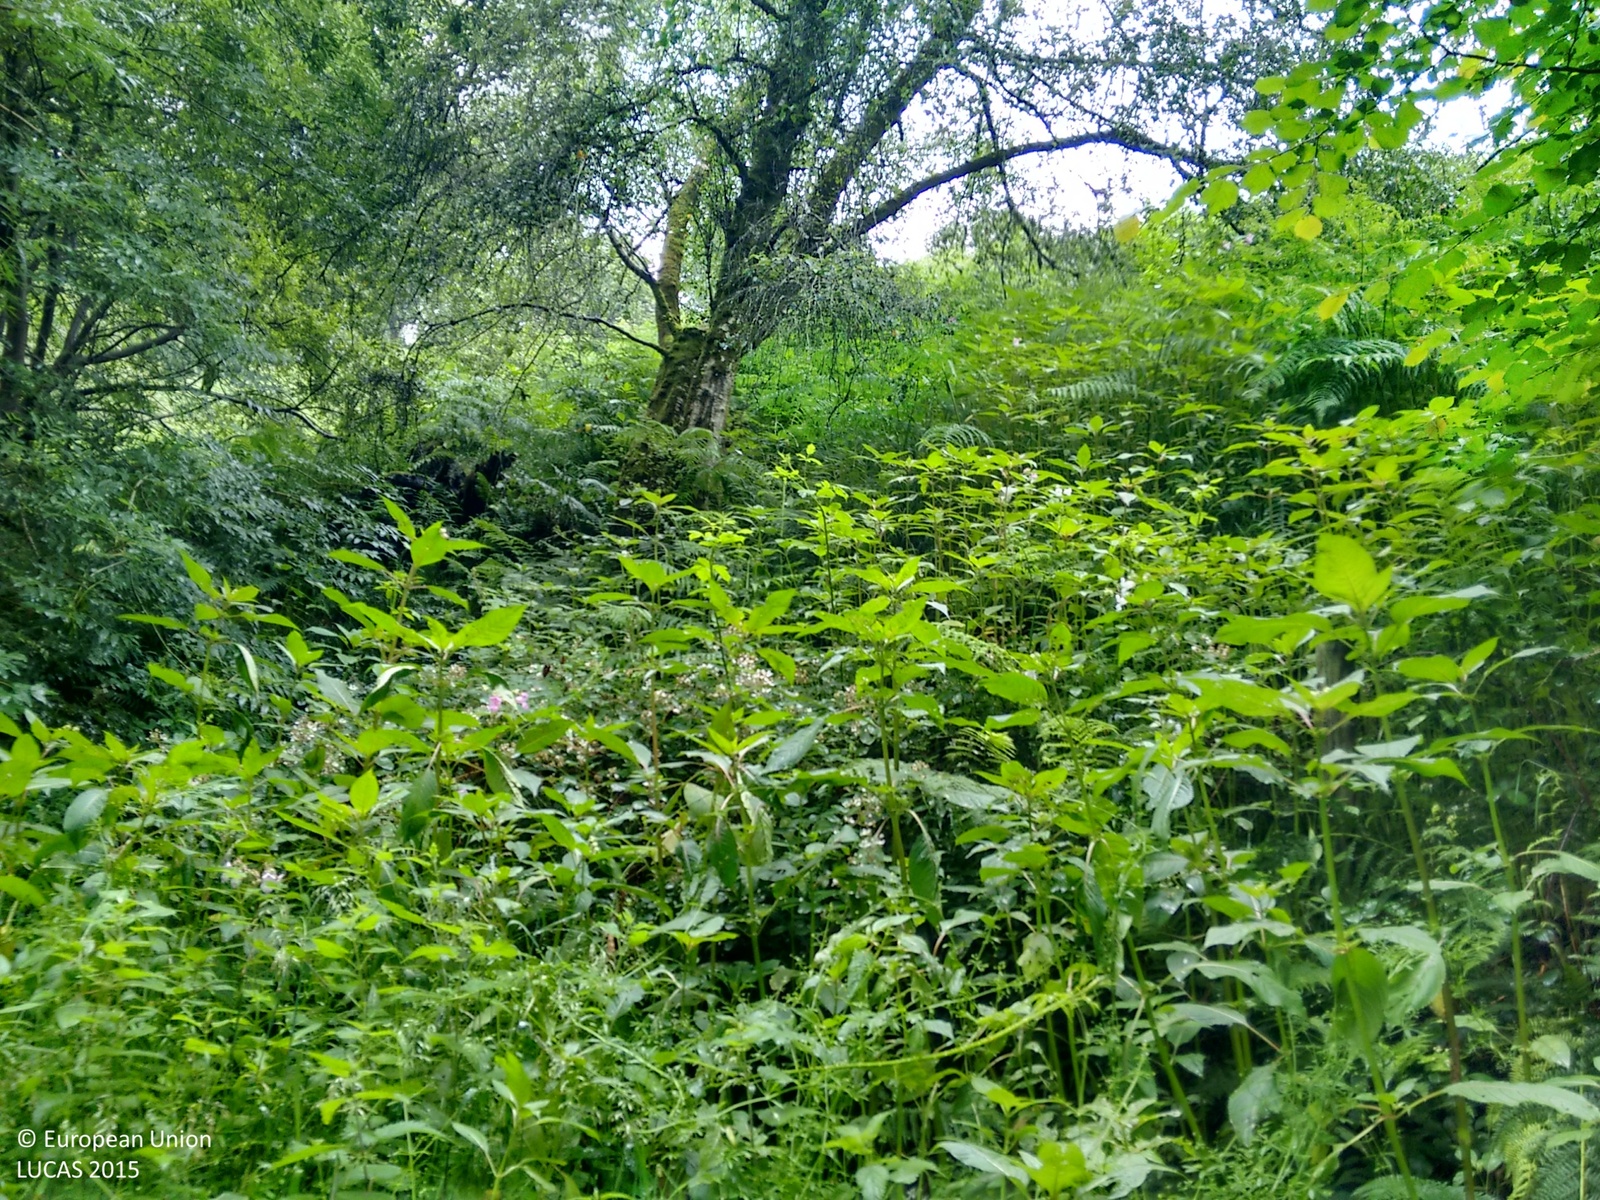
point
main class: Woodland
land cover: Broadleaved woodland
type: mesophytic deciduous forest
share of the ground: > 75 %
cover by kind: broadleaved forest trees 50 %, shrubs 50 %
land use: Forestry
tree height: > 5 m
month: July
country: GB
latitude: 51.6151
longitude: -3.3833
